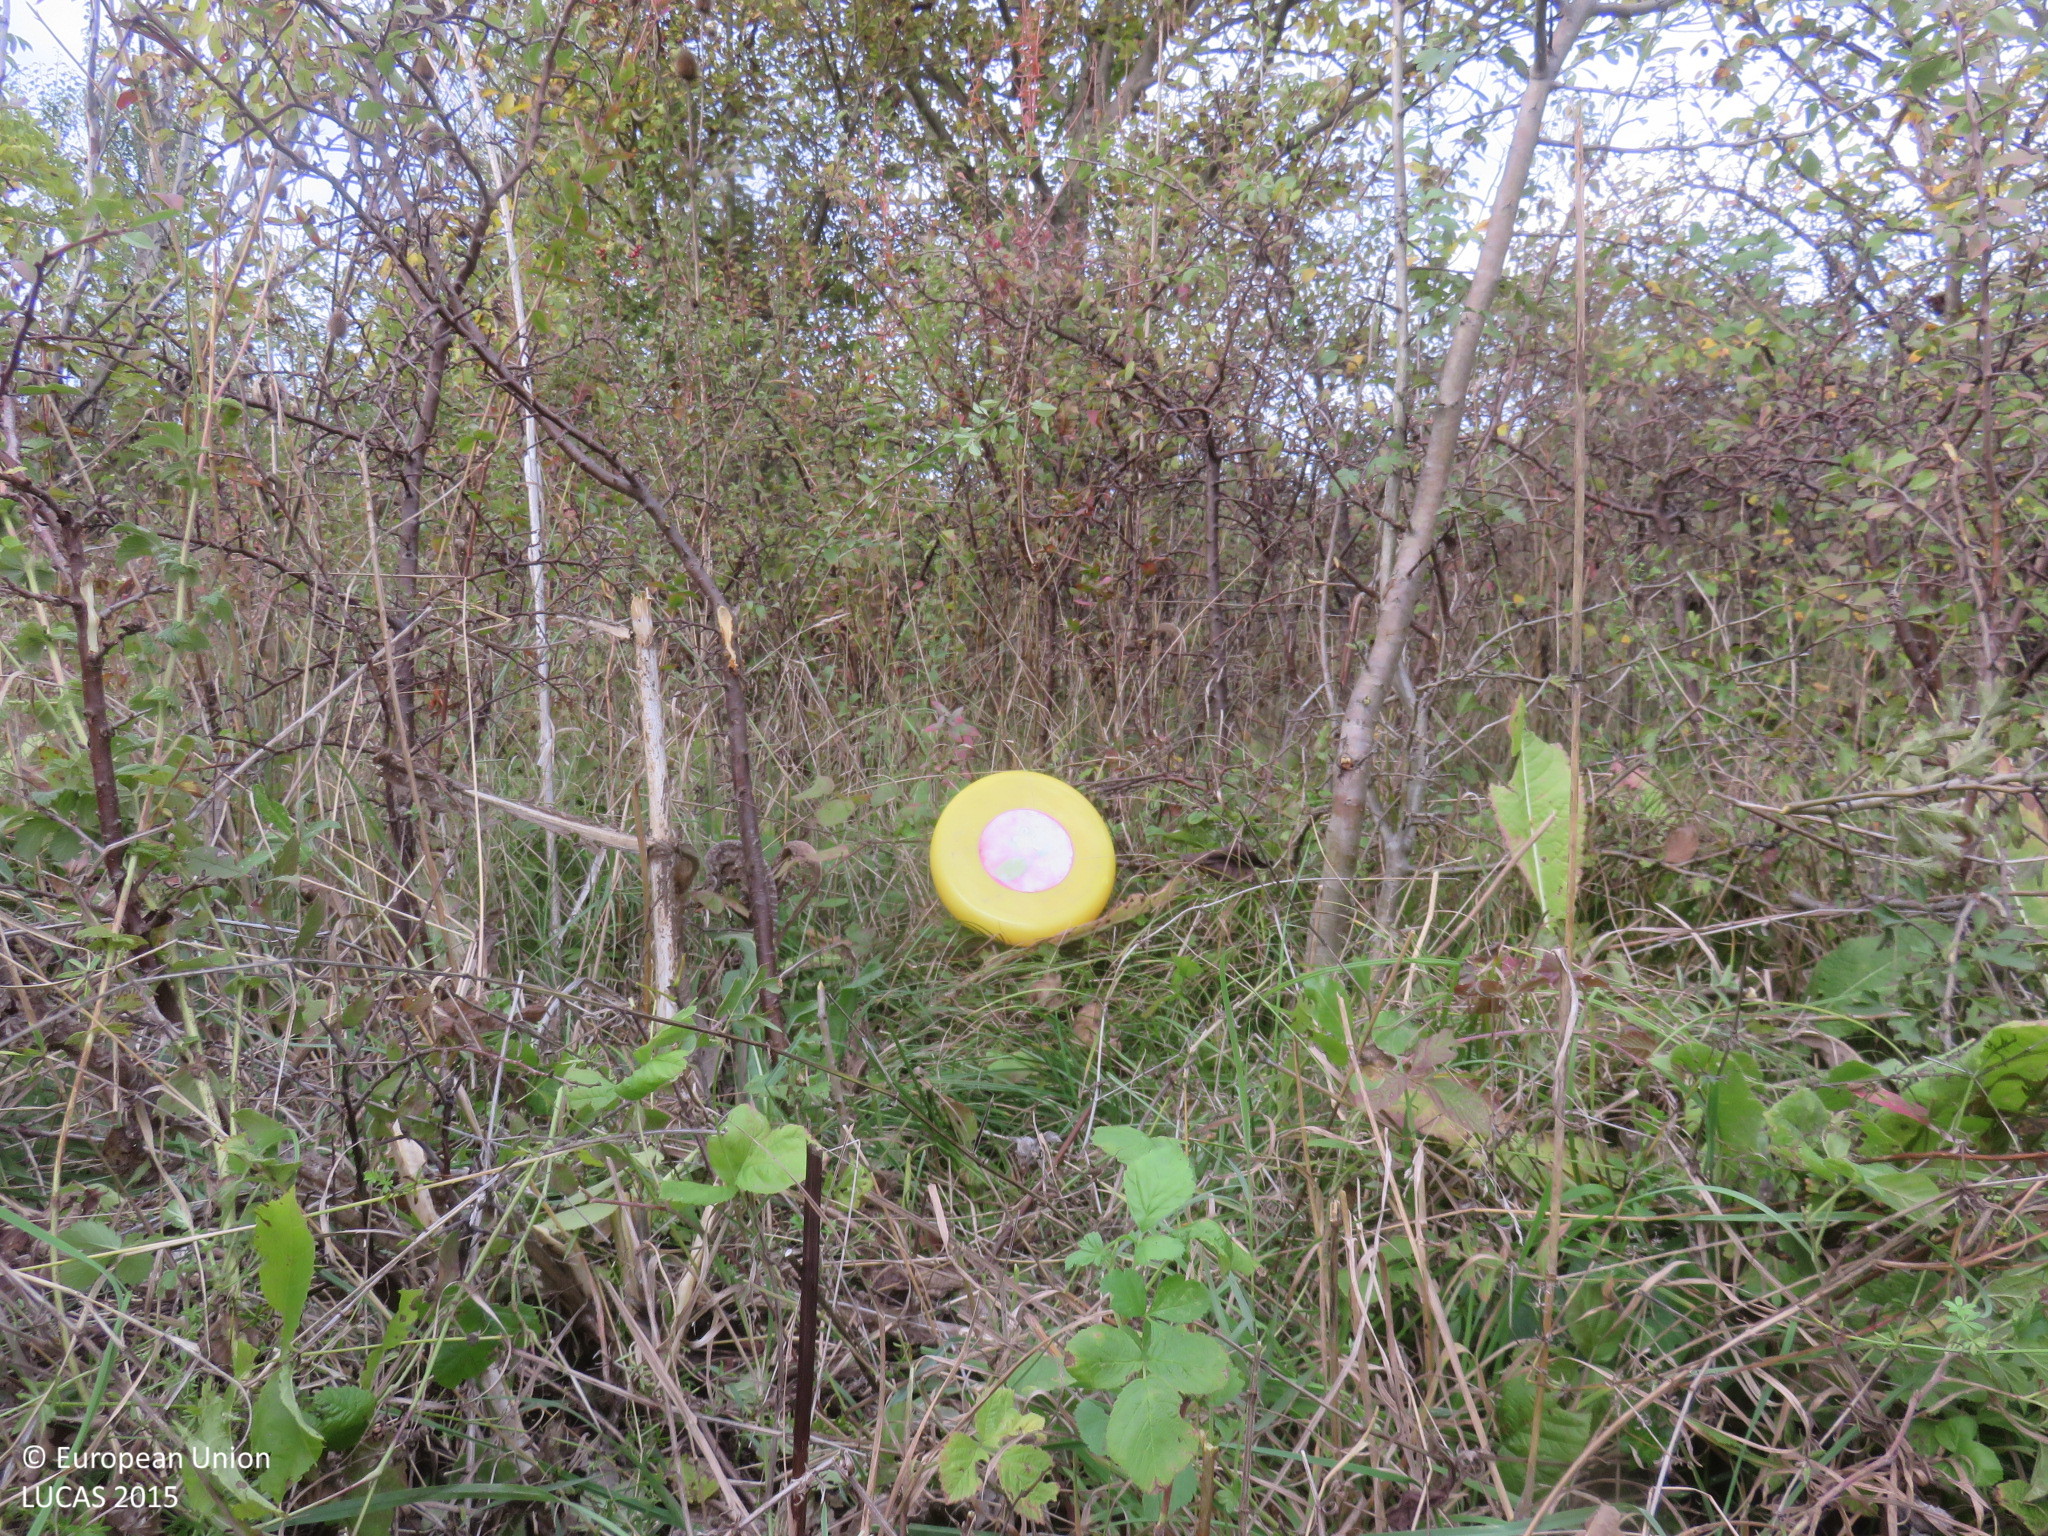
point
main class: Shrubland
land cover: Shrubland with sparse tree cover
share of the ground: > 75 %
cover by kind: shrubs 95 %, broadleaved forest trees 5 %
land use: Abandoned areas
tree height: < 5 m
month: October
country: BG
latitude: 43.1235
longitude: 25.2521
